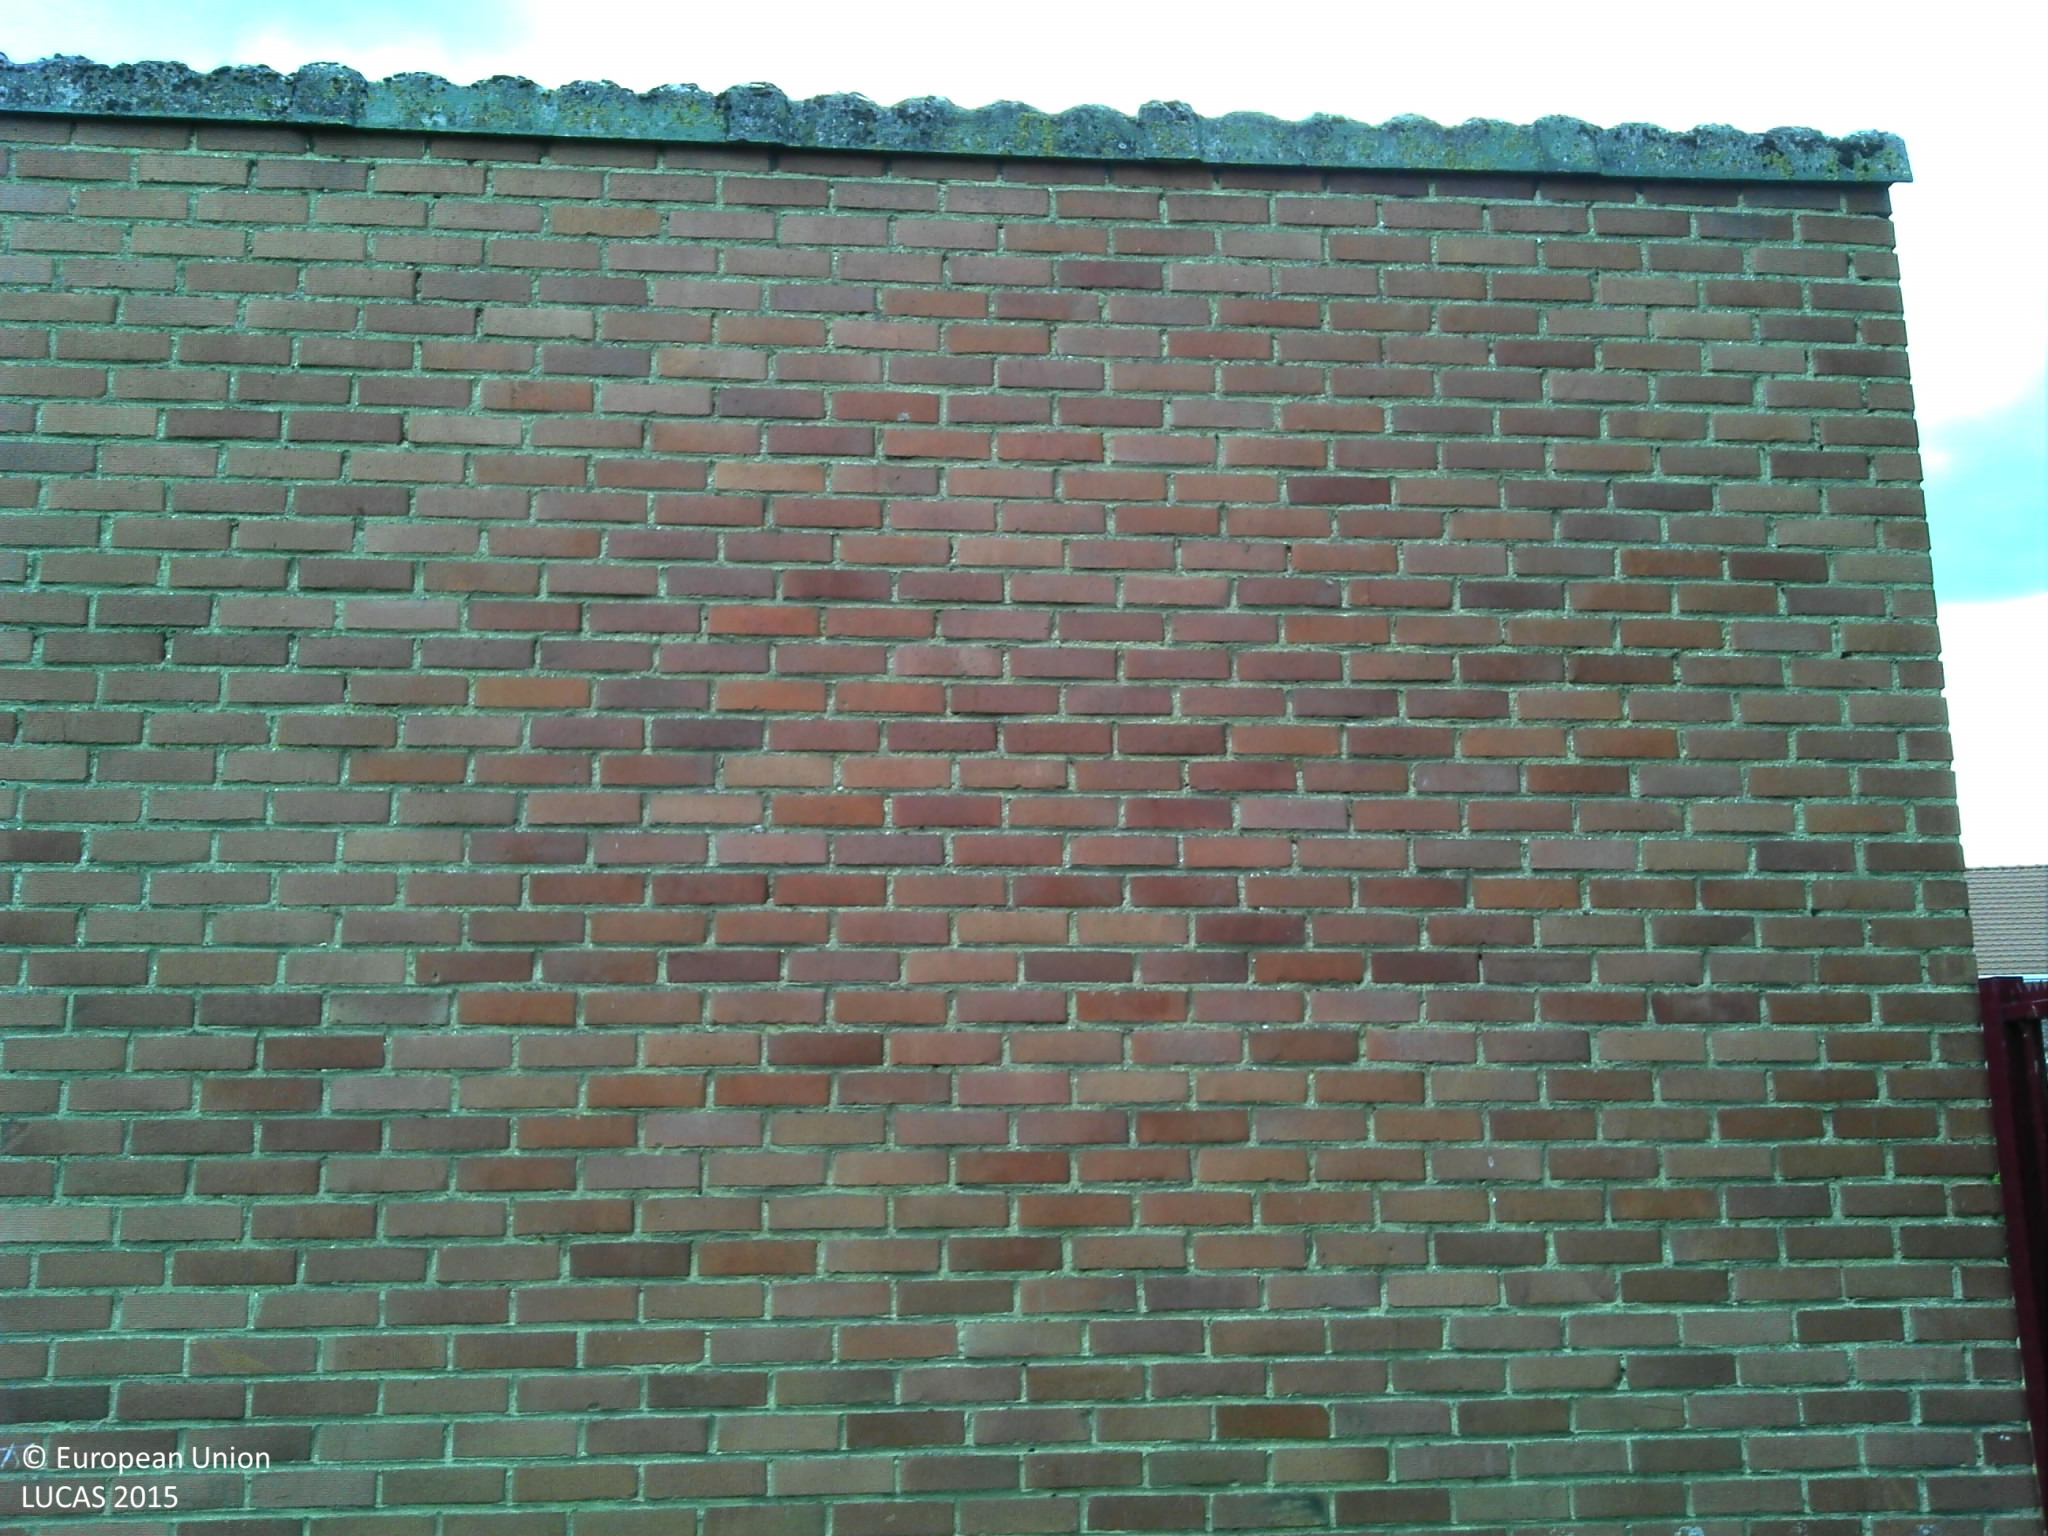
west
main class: Grassland
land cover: Grassland without tree/shrub cover
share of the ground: > 75 %
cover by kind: herbaceous plants 100 %
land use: Community services
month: July
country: FR
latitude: 50.4545
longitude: 3.5841
